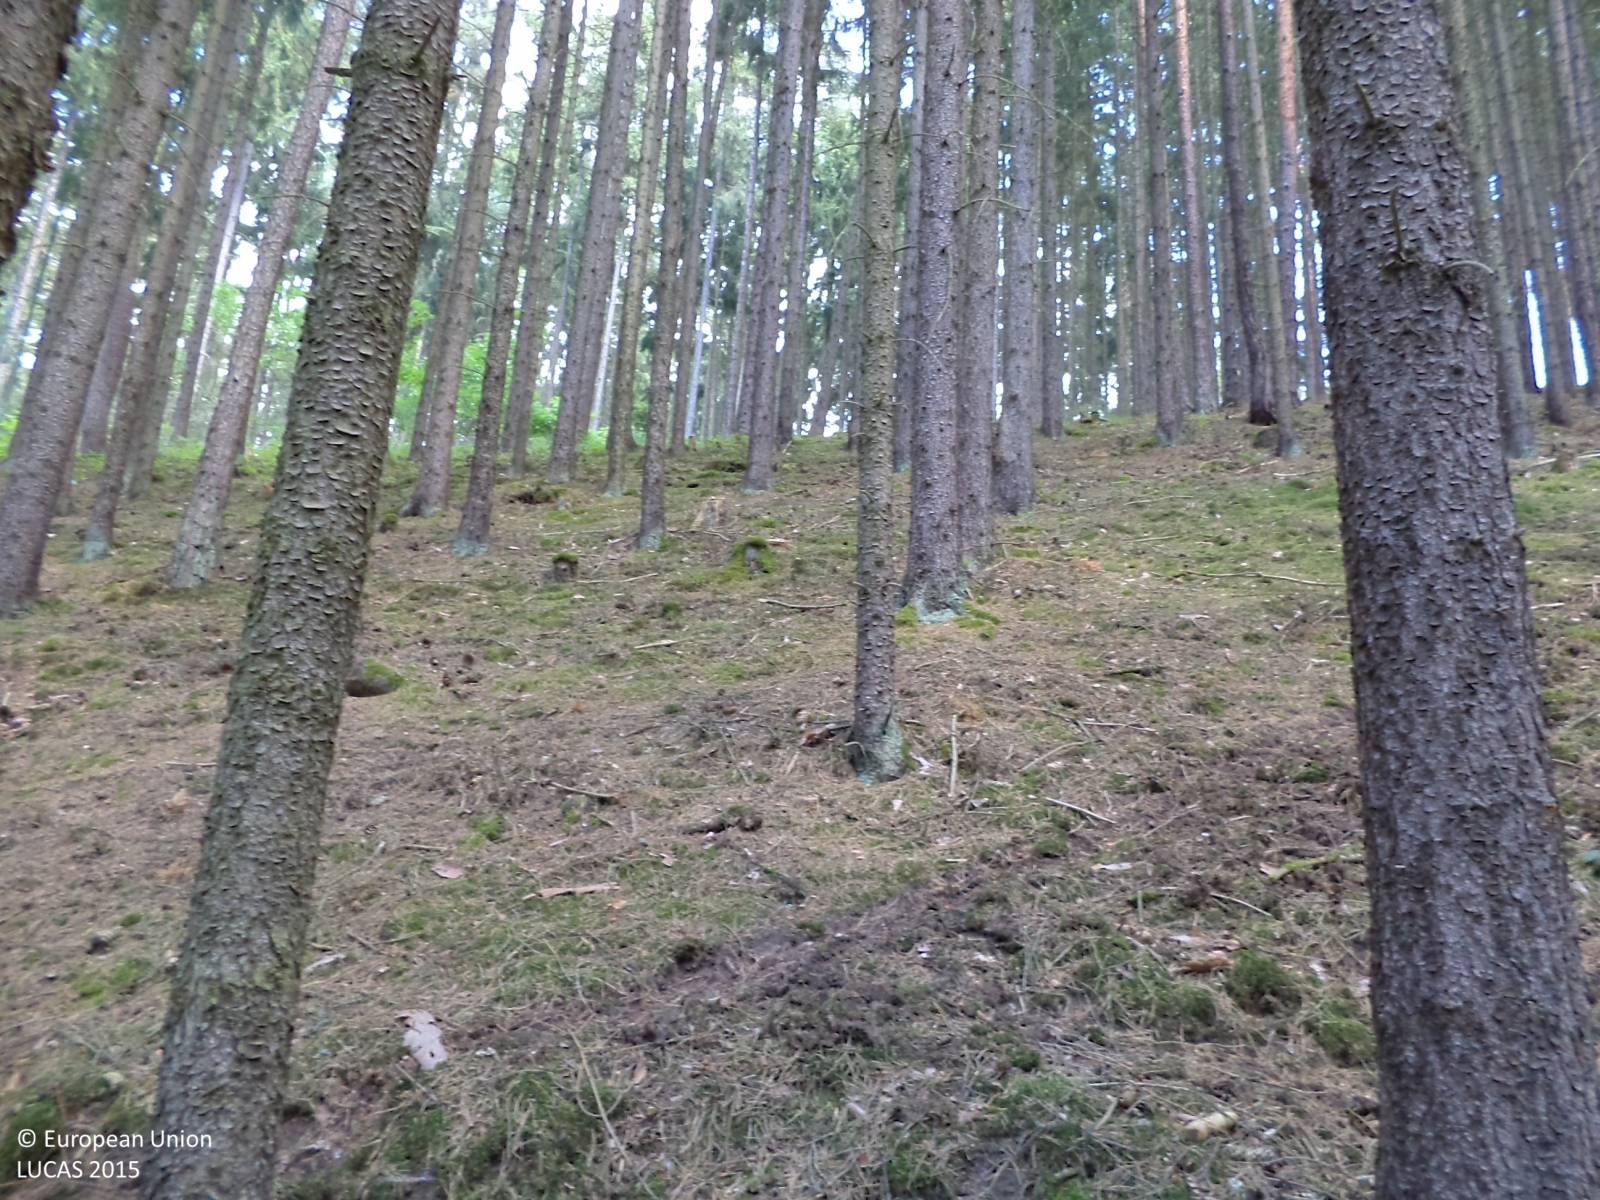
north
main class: Woodland
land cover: Spruce dominated coniferous woodland
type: hemiboreal forest and nemoral coniferous forest and mixed broadleaved-coniferous forest
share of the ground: > 75 %
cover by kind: coniferous forest trees 95 %, lichens and mosses 5 %
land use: Forestry
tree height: > 5 m
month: July
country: CZ
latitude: 49.3475
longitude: 14.2820
